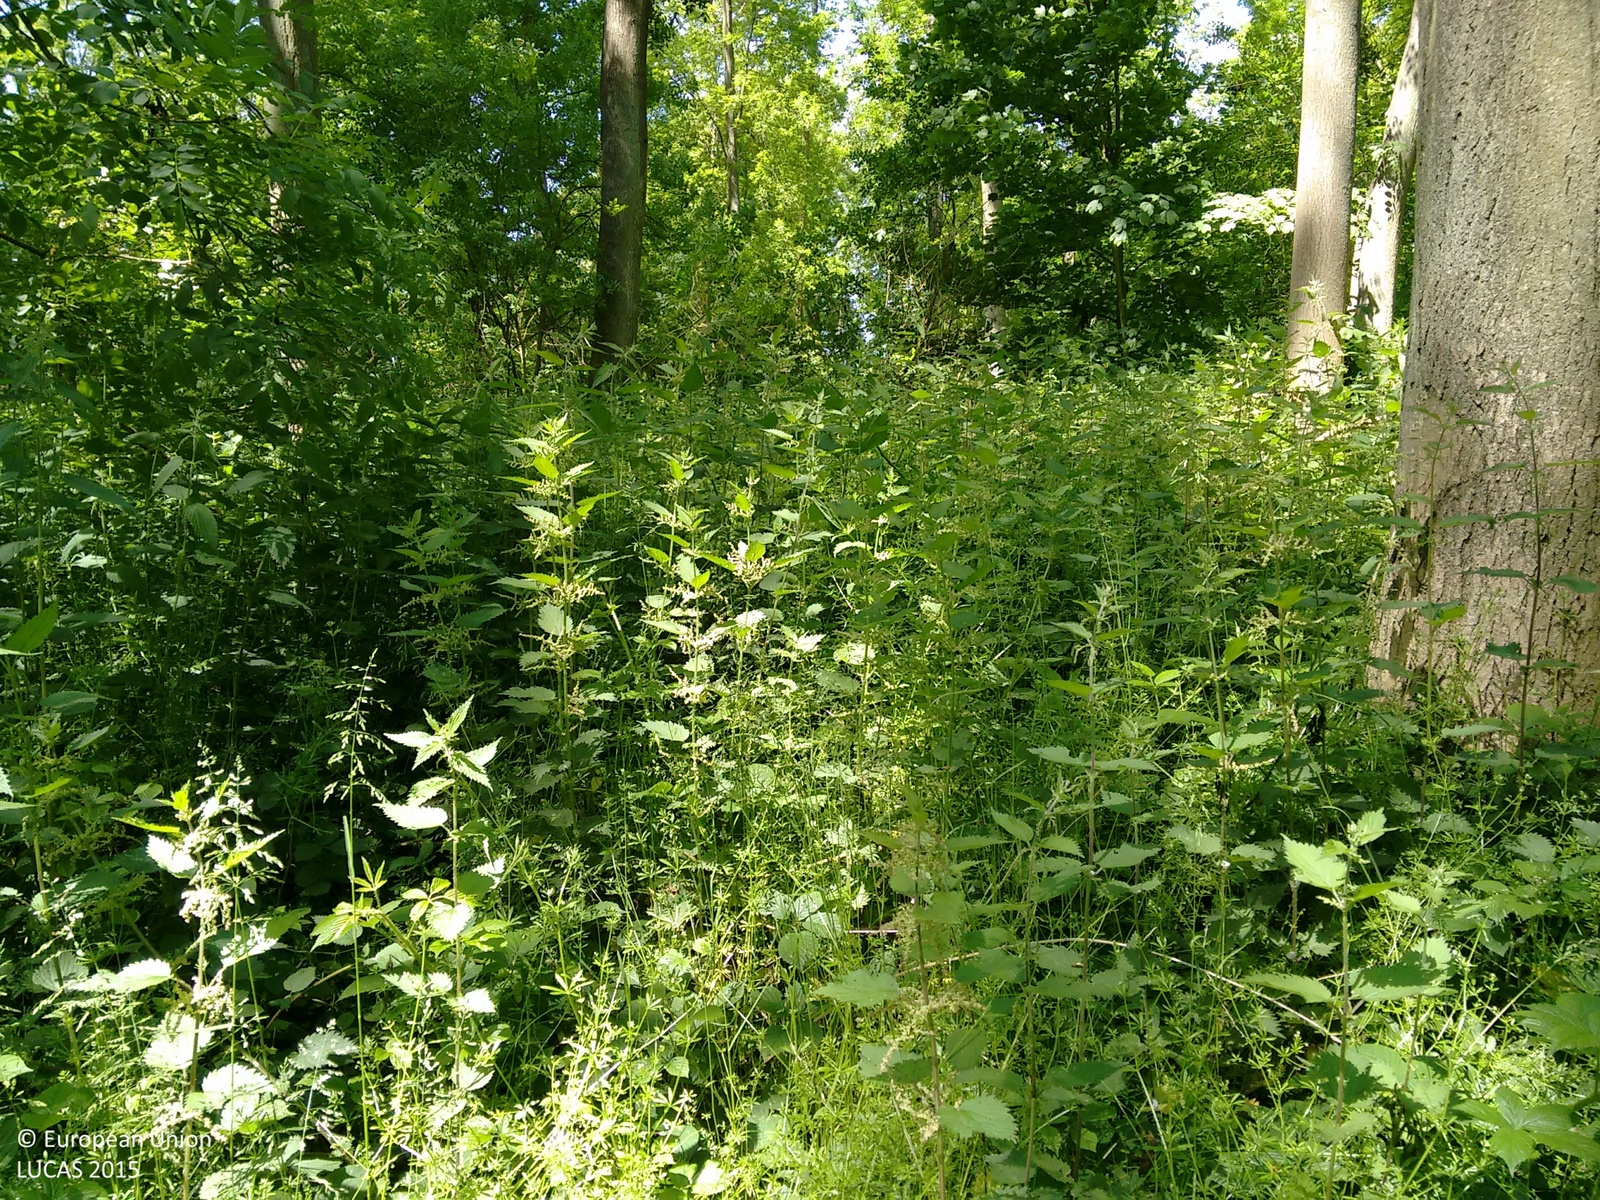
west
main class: Woodland
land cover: Broadleaved woodland
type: mesophytic deciduous forest
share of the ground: > 75 %
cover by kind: broadleaved forest trees 100 %
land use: Forestry
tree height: > 5 m
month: June
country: GB
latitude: 52.9364
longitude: -0.5878
